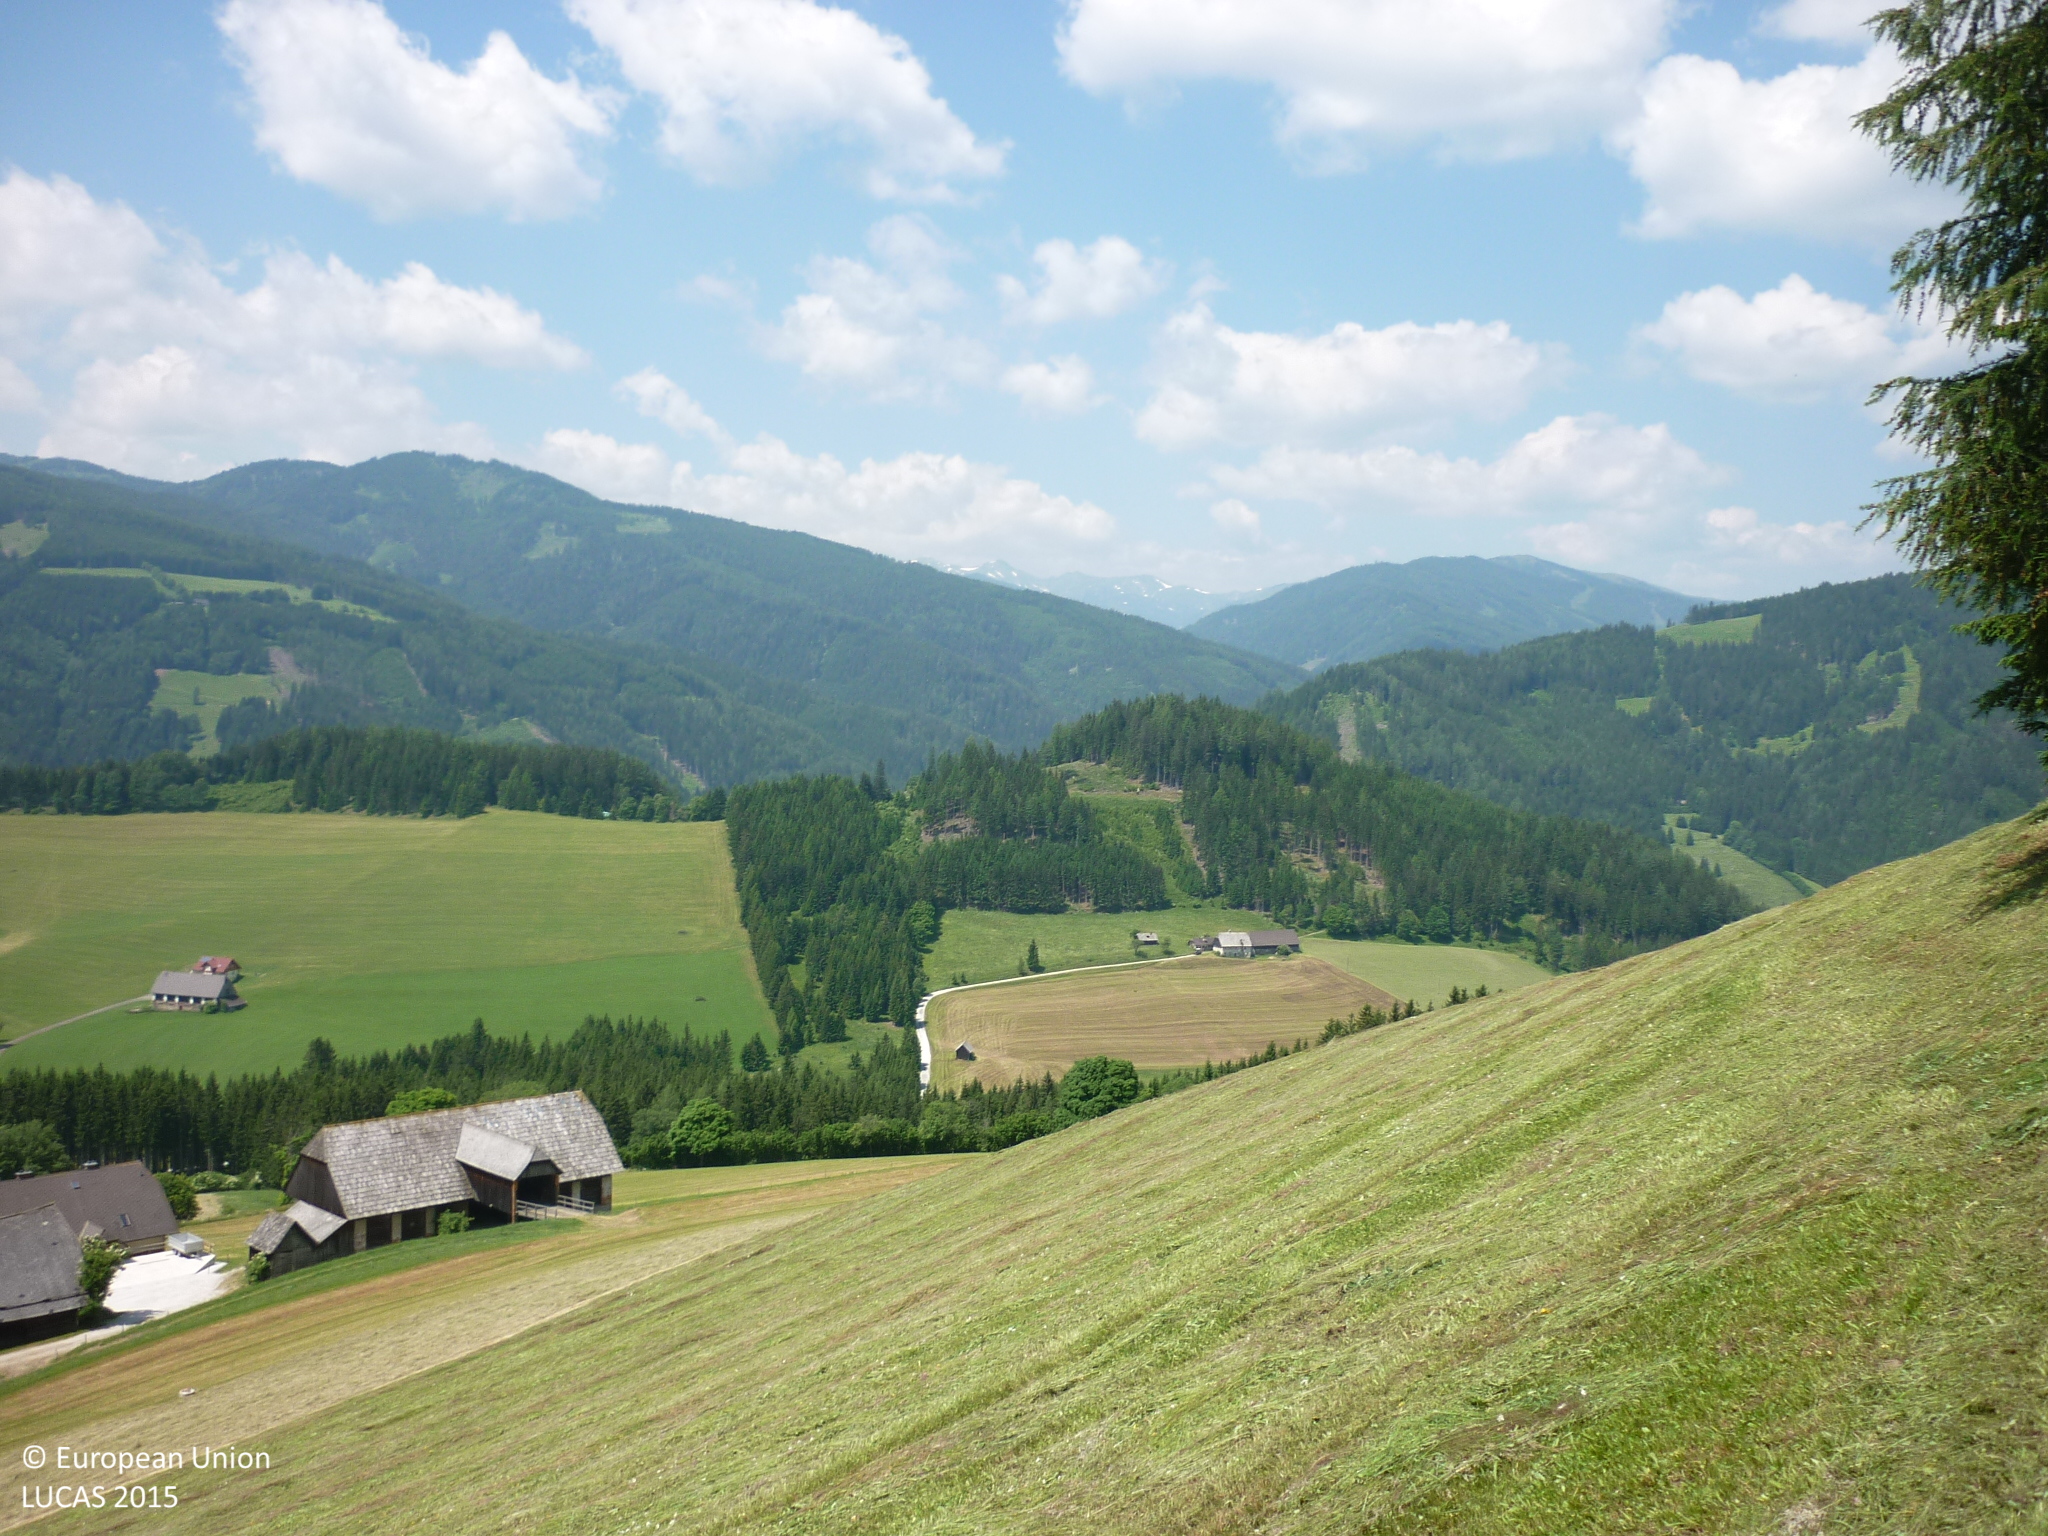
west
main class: Grassland
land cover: Grassland without tree/shrub cover
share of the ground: > 75 %
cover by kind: herbaceous plants 100 %
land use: Agriculture (excluding fallow land and kitchen gardens)
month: June
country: AT
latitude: 47.2842
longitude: 14.5073
